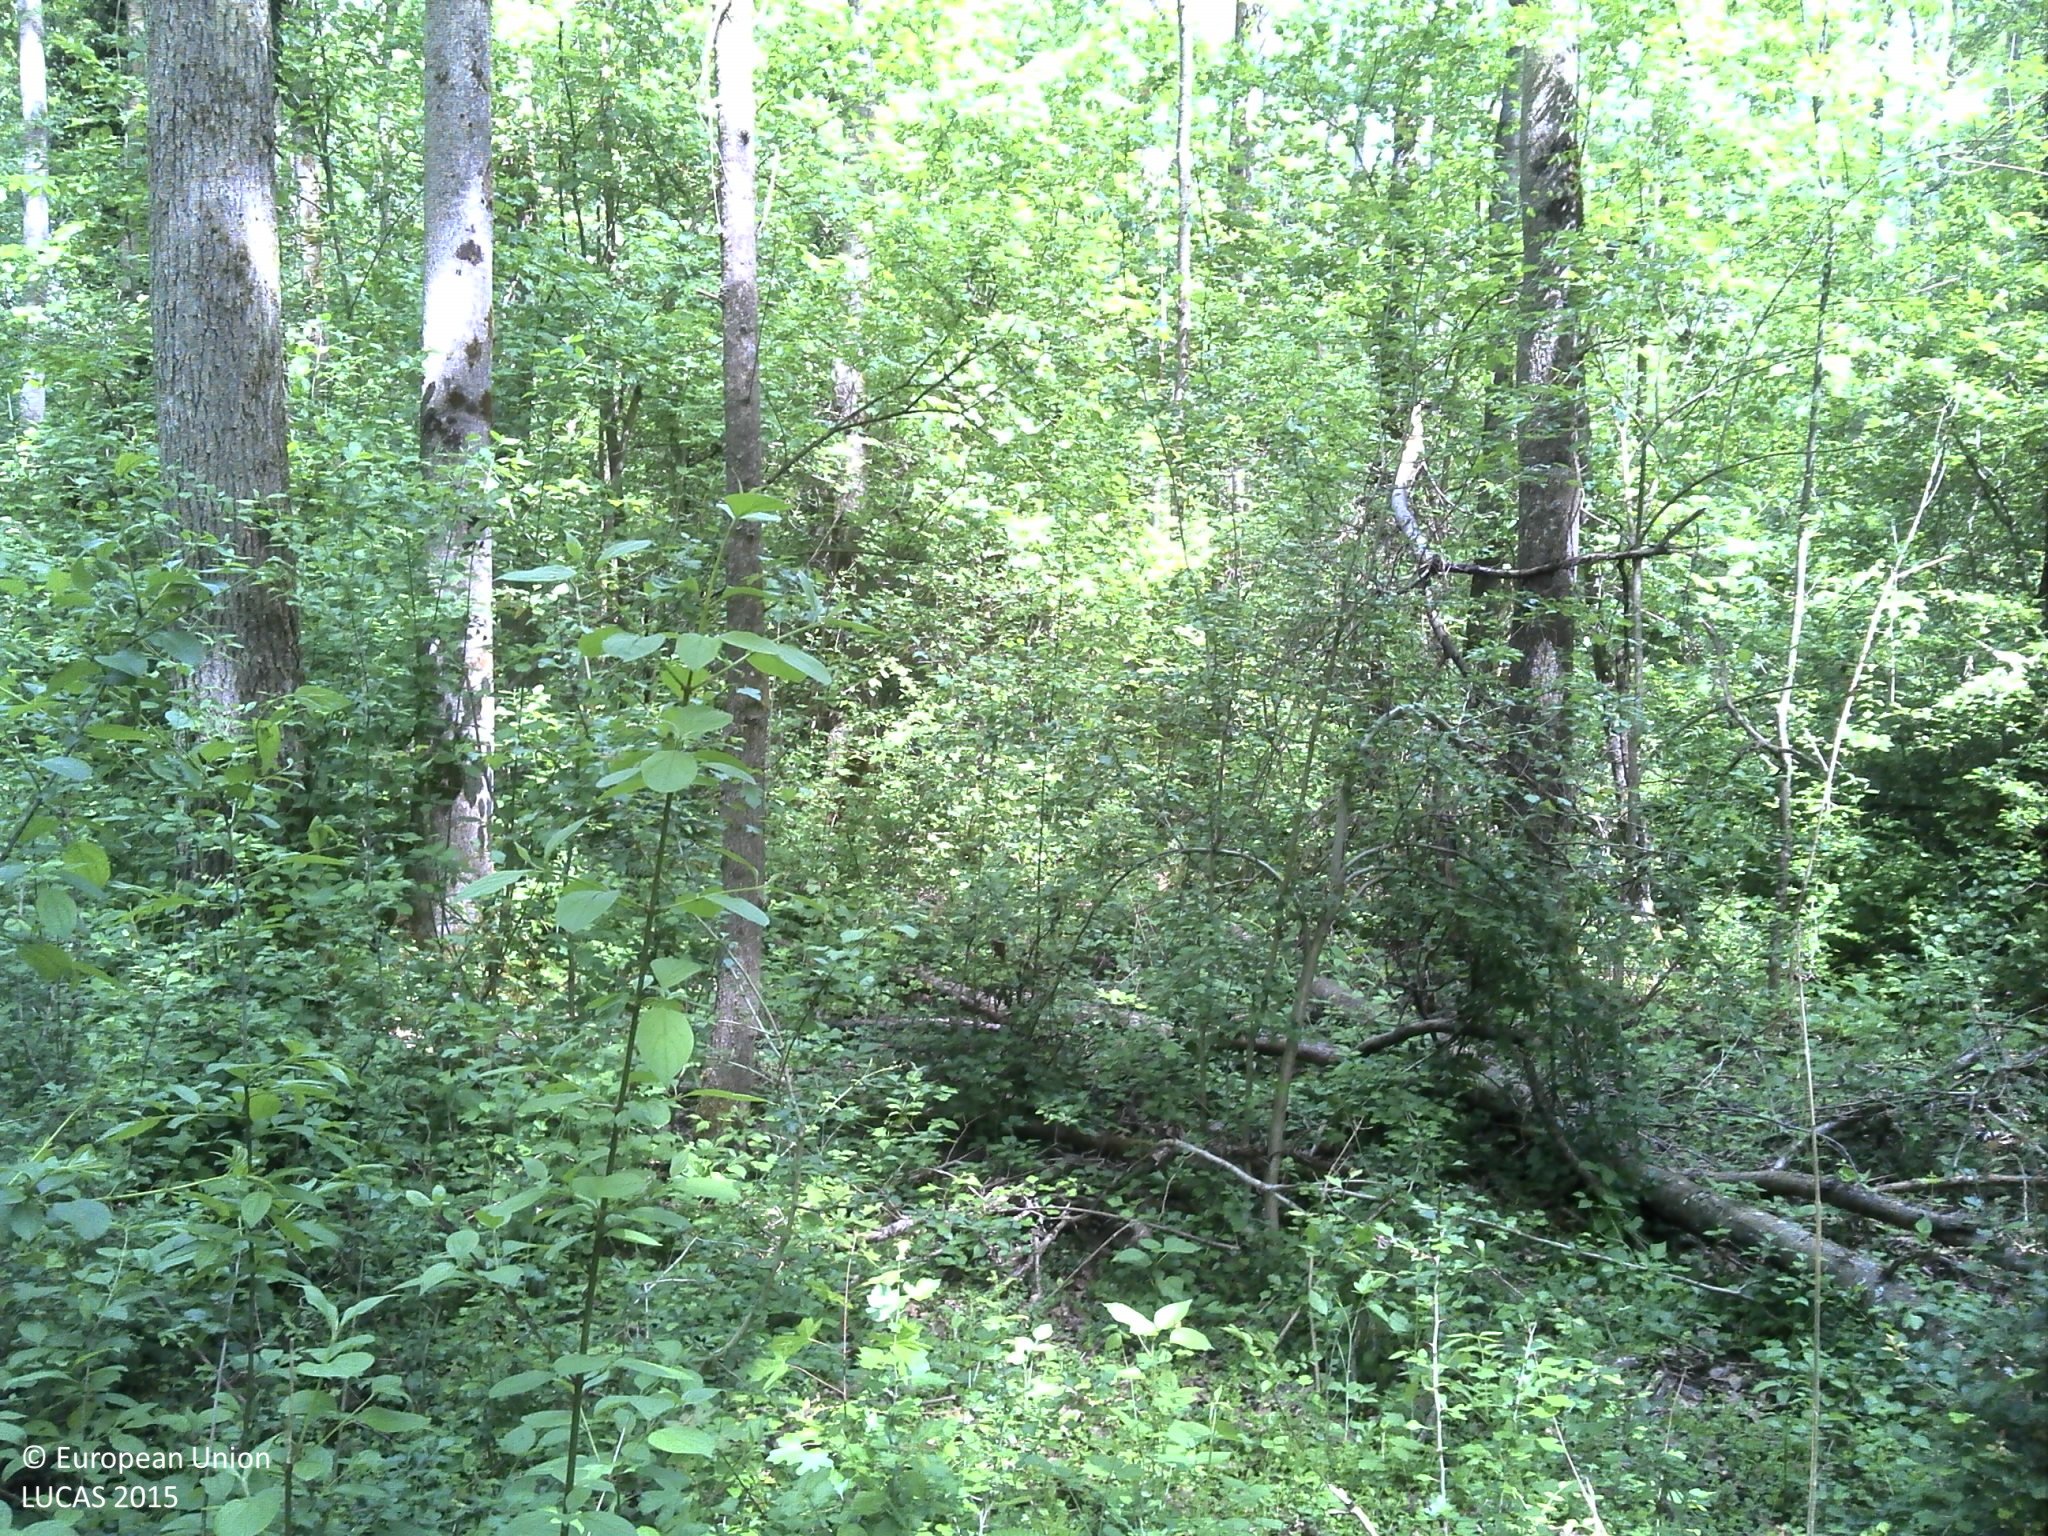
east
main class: Woodland
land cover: Broadleaved woodland
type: acidophilous oak and oak-birch forest
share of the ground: > 75 %
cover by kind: broadleaved forest trees 100 %
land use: Forestry
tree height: > 5 m
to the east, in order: Broadleaved woodland
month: May
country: HR
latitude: 45.1158
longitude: 18.6110
